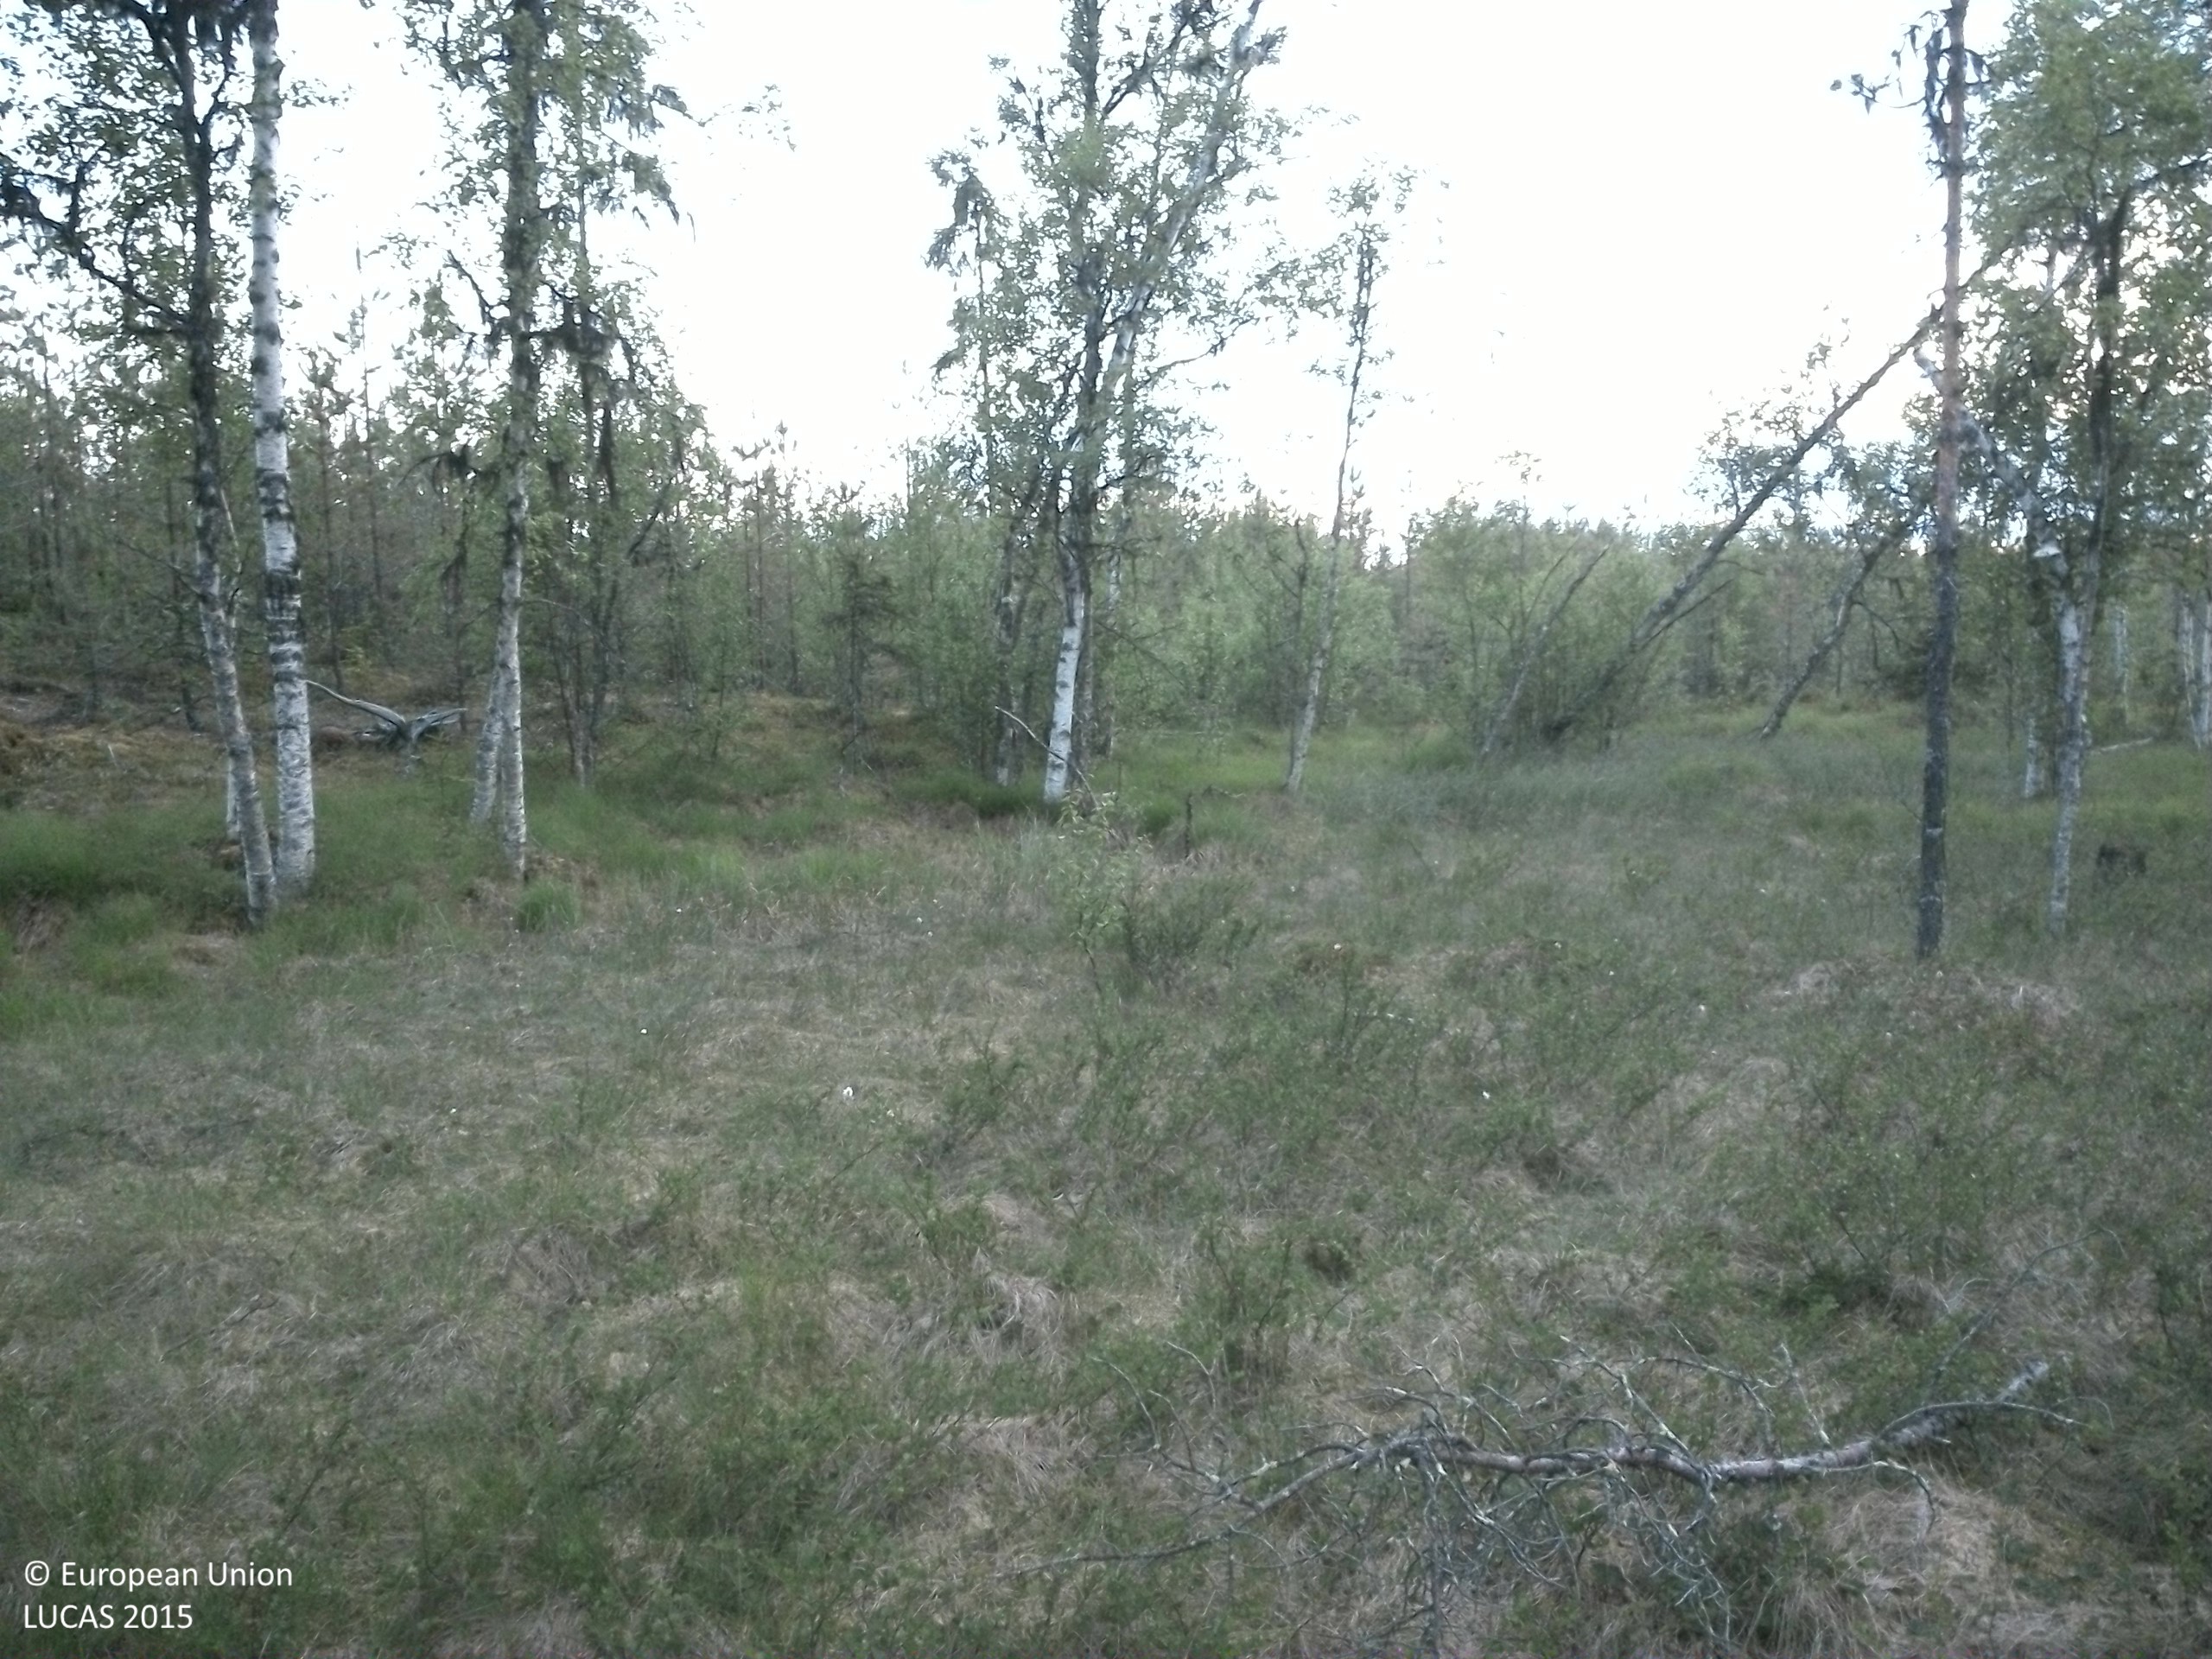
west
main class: Woodland
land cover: Pine dominated mixed woodland
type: boreal forest
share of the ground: 10 - 25 %
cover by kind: herbaceous plants 35 %, shrubs 25 %, coniferous forest trees 15 %, lichens and mosses 15 %, broadleaved forest trees 10 %
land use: Forestry
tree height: > 5 m
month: July
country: SE
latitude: 64.2824
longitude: 16.5166
